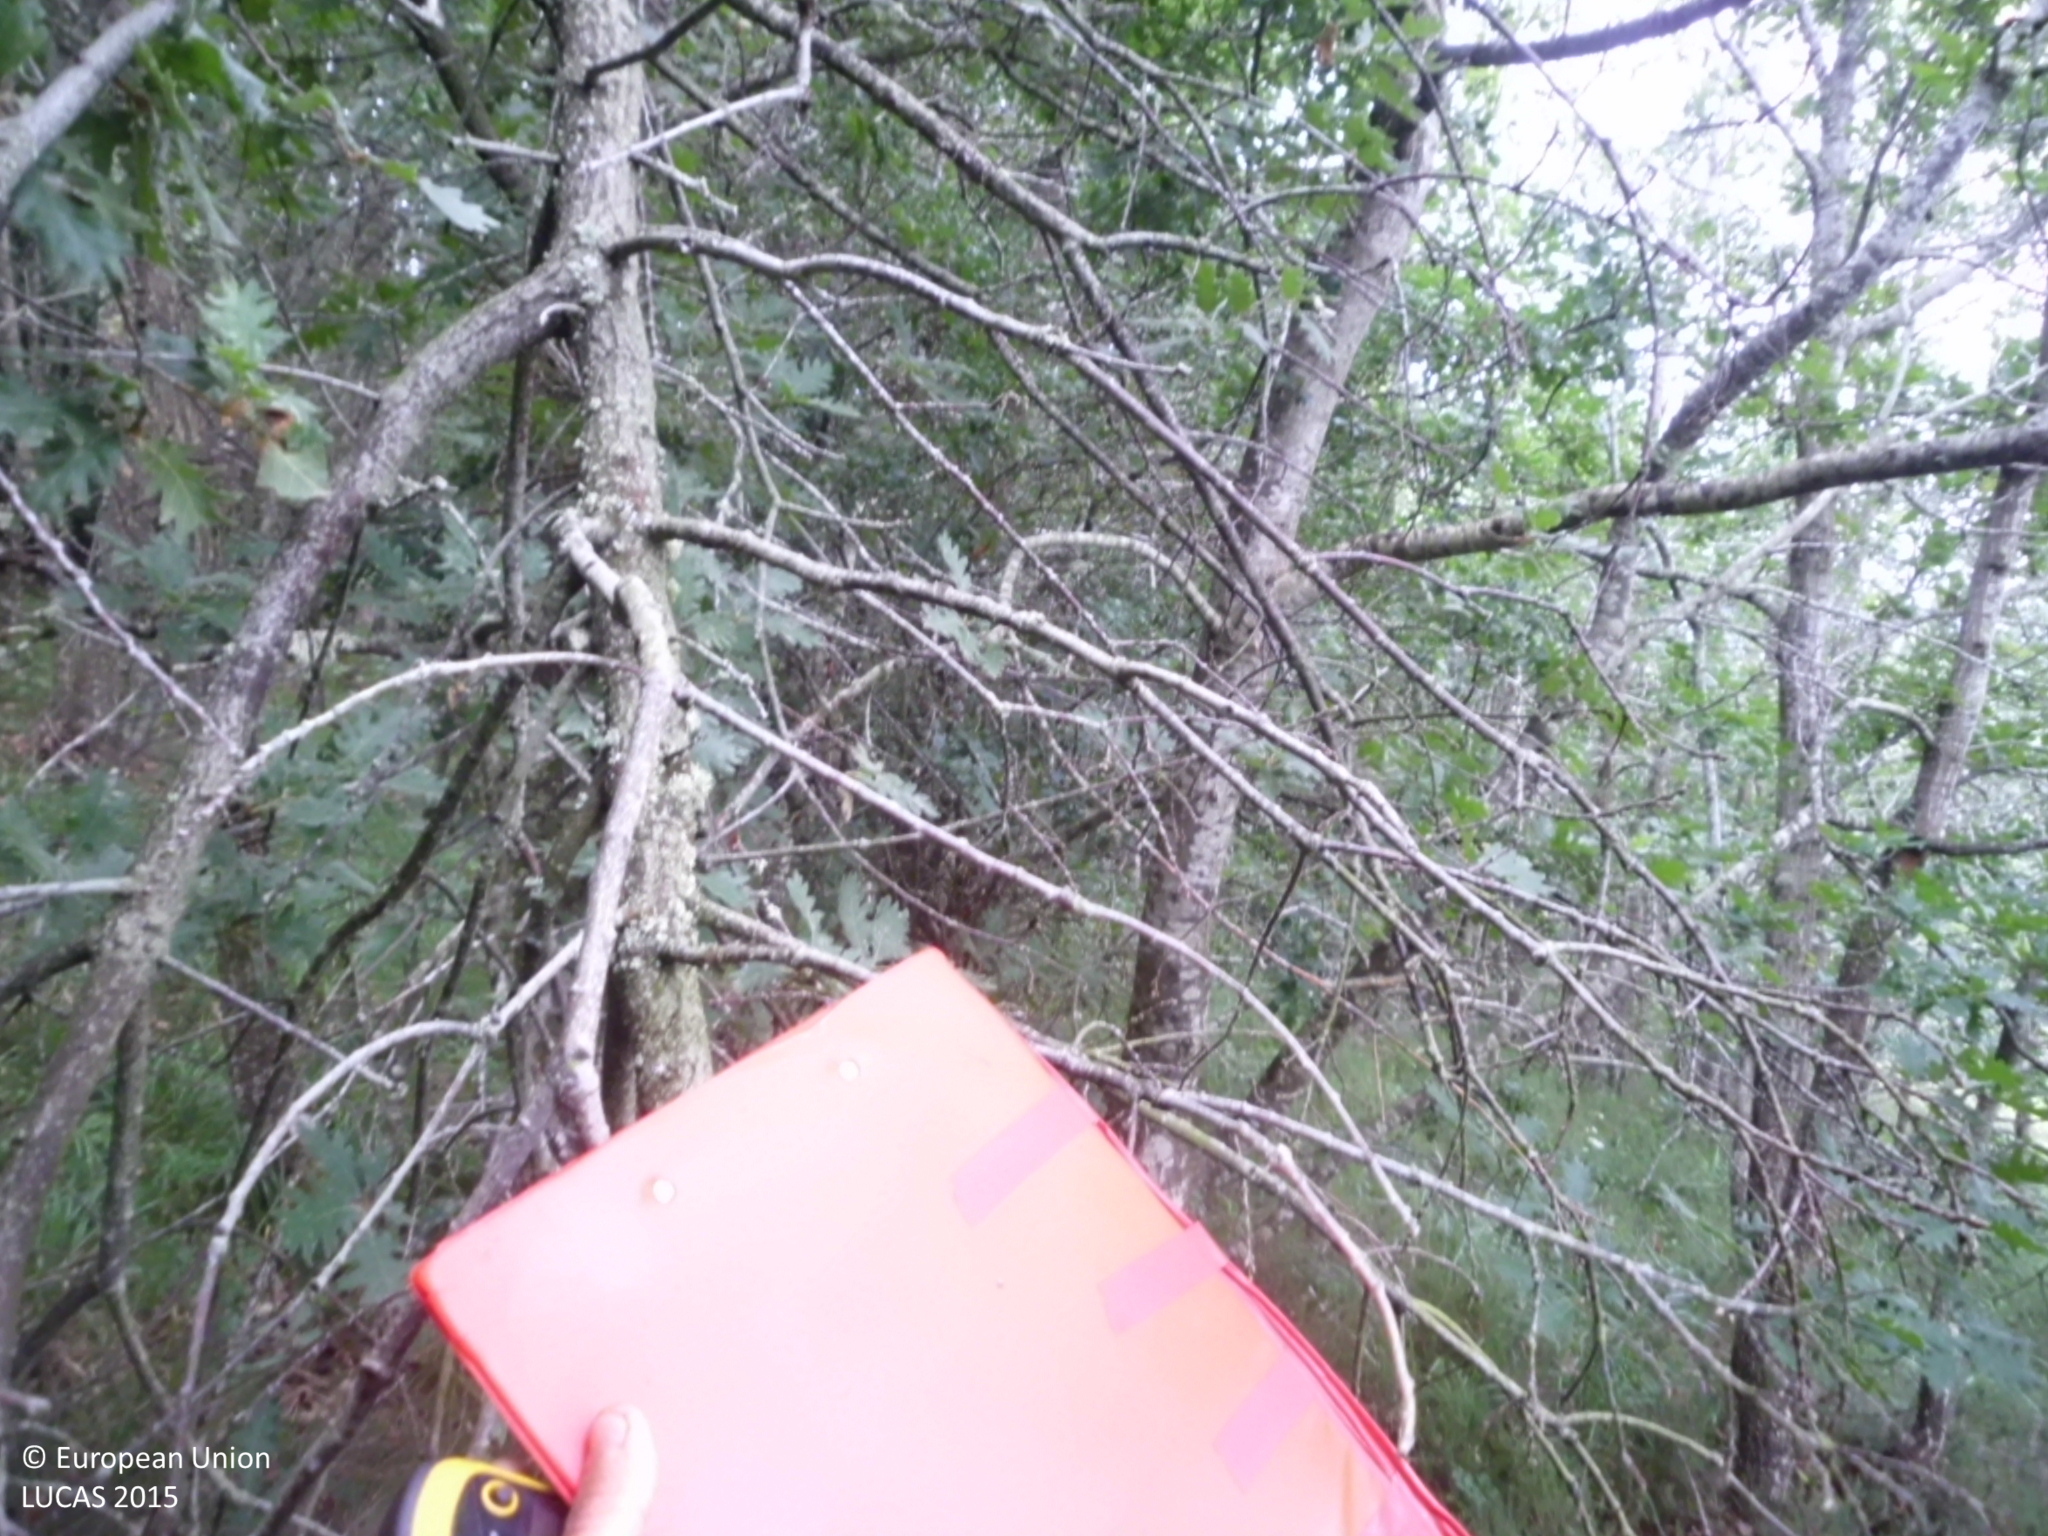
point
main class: Woodland
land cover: Broadleaved woodland
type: acidophilous oak and oak-birch forest
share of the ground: > 75 %
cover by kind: broadleaved forest trees 95 %, shrubs 5 %
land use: Semi-natural and natural areas not in use
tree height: > 5 m
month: July
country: ES
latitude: 42.8648
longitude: -4.1369
